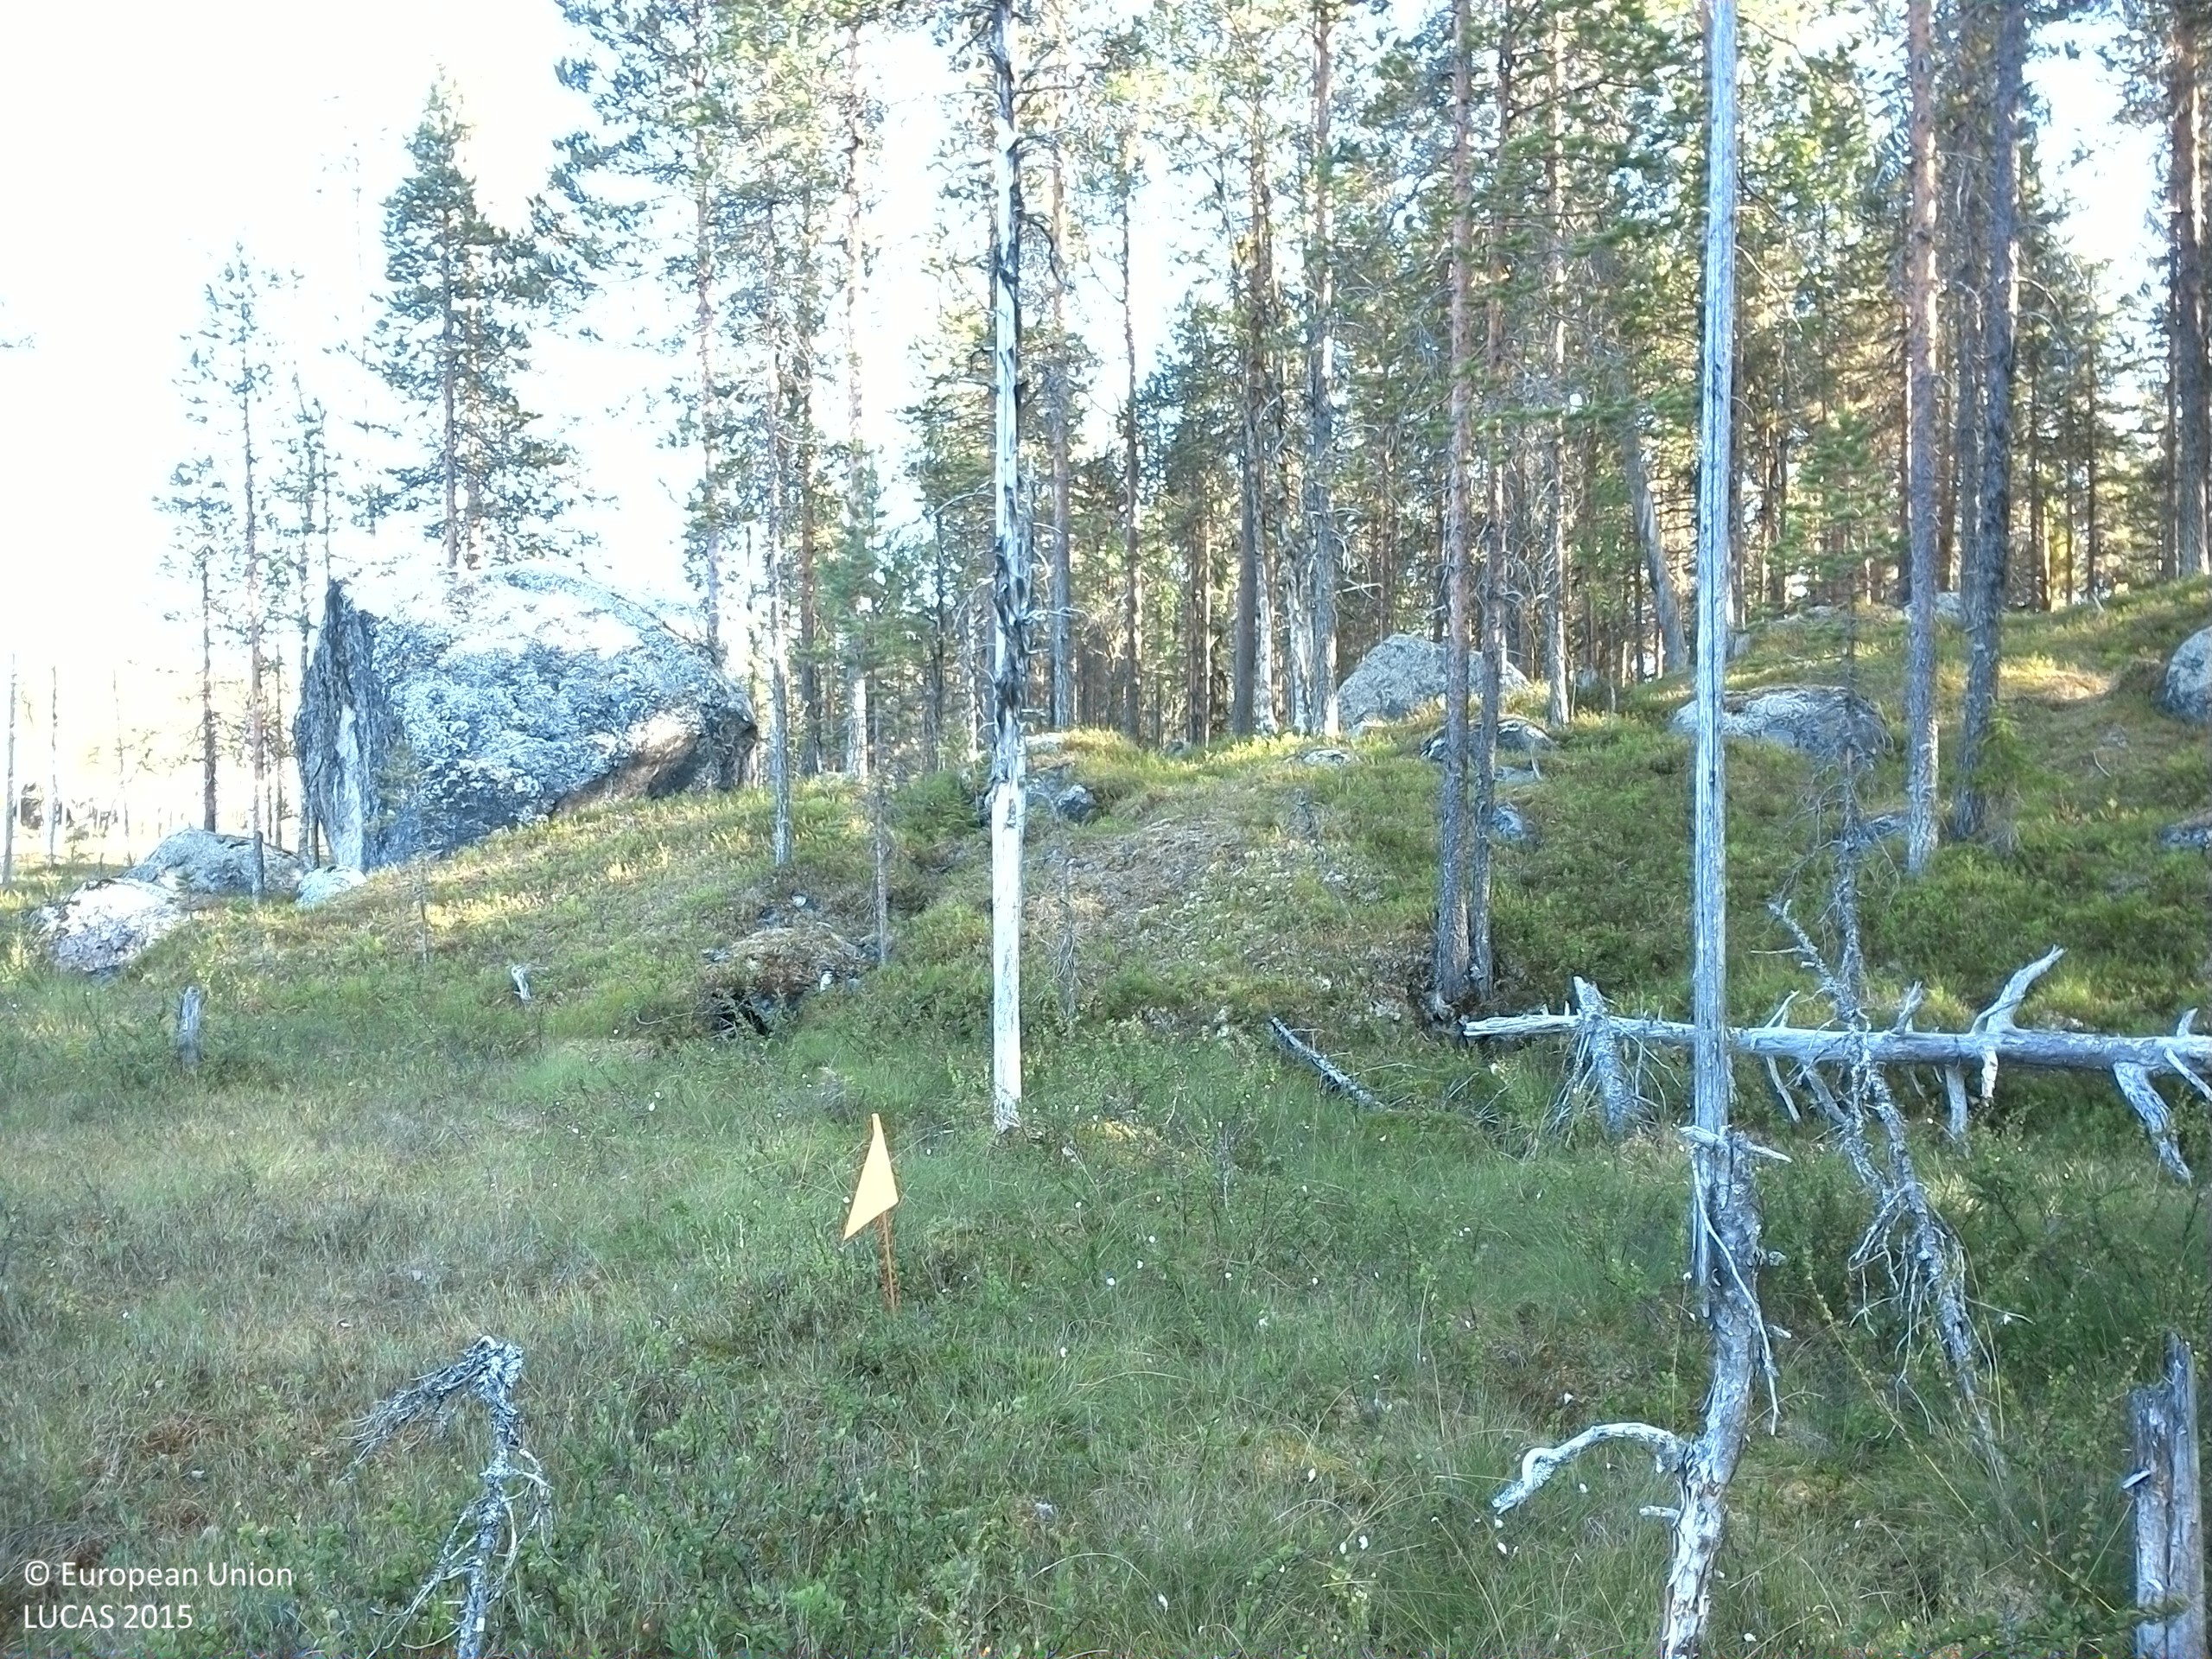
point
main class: Woodland
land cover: Broadleaved woodland
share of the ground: 25 - 50 %
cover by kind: broadleaved forest trees 40 %, herbaceous plants 30 %, lichens and mosses 25 %, shrubs 5 %
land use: Semi-natural and natural areas not in use
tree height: < 5 m
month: August
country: SE
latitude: 64.0918
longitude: 17.5394
